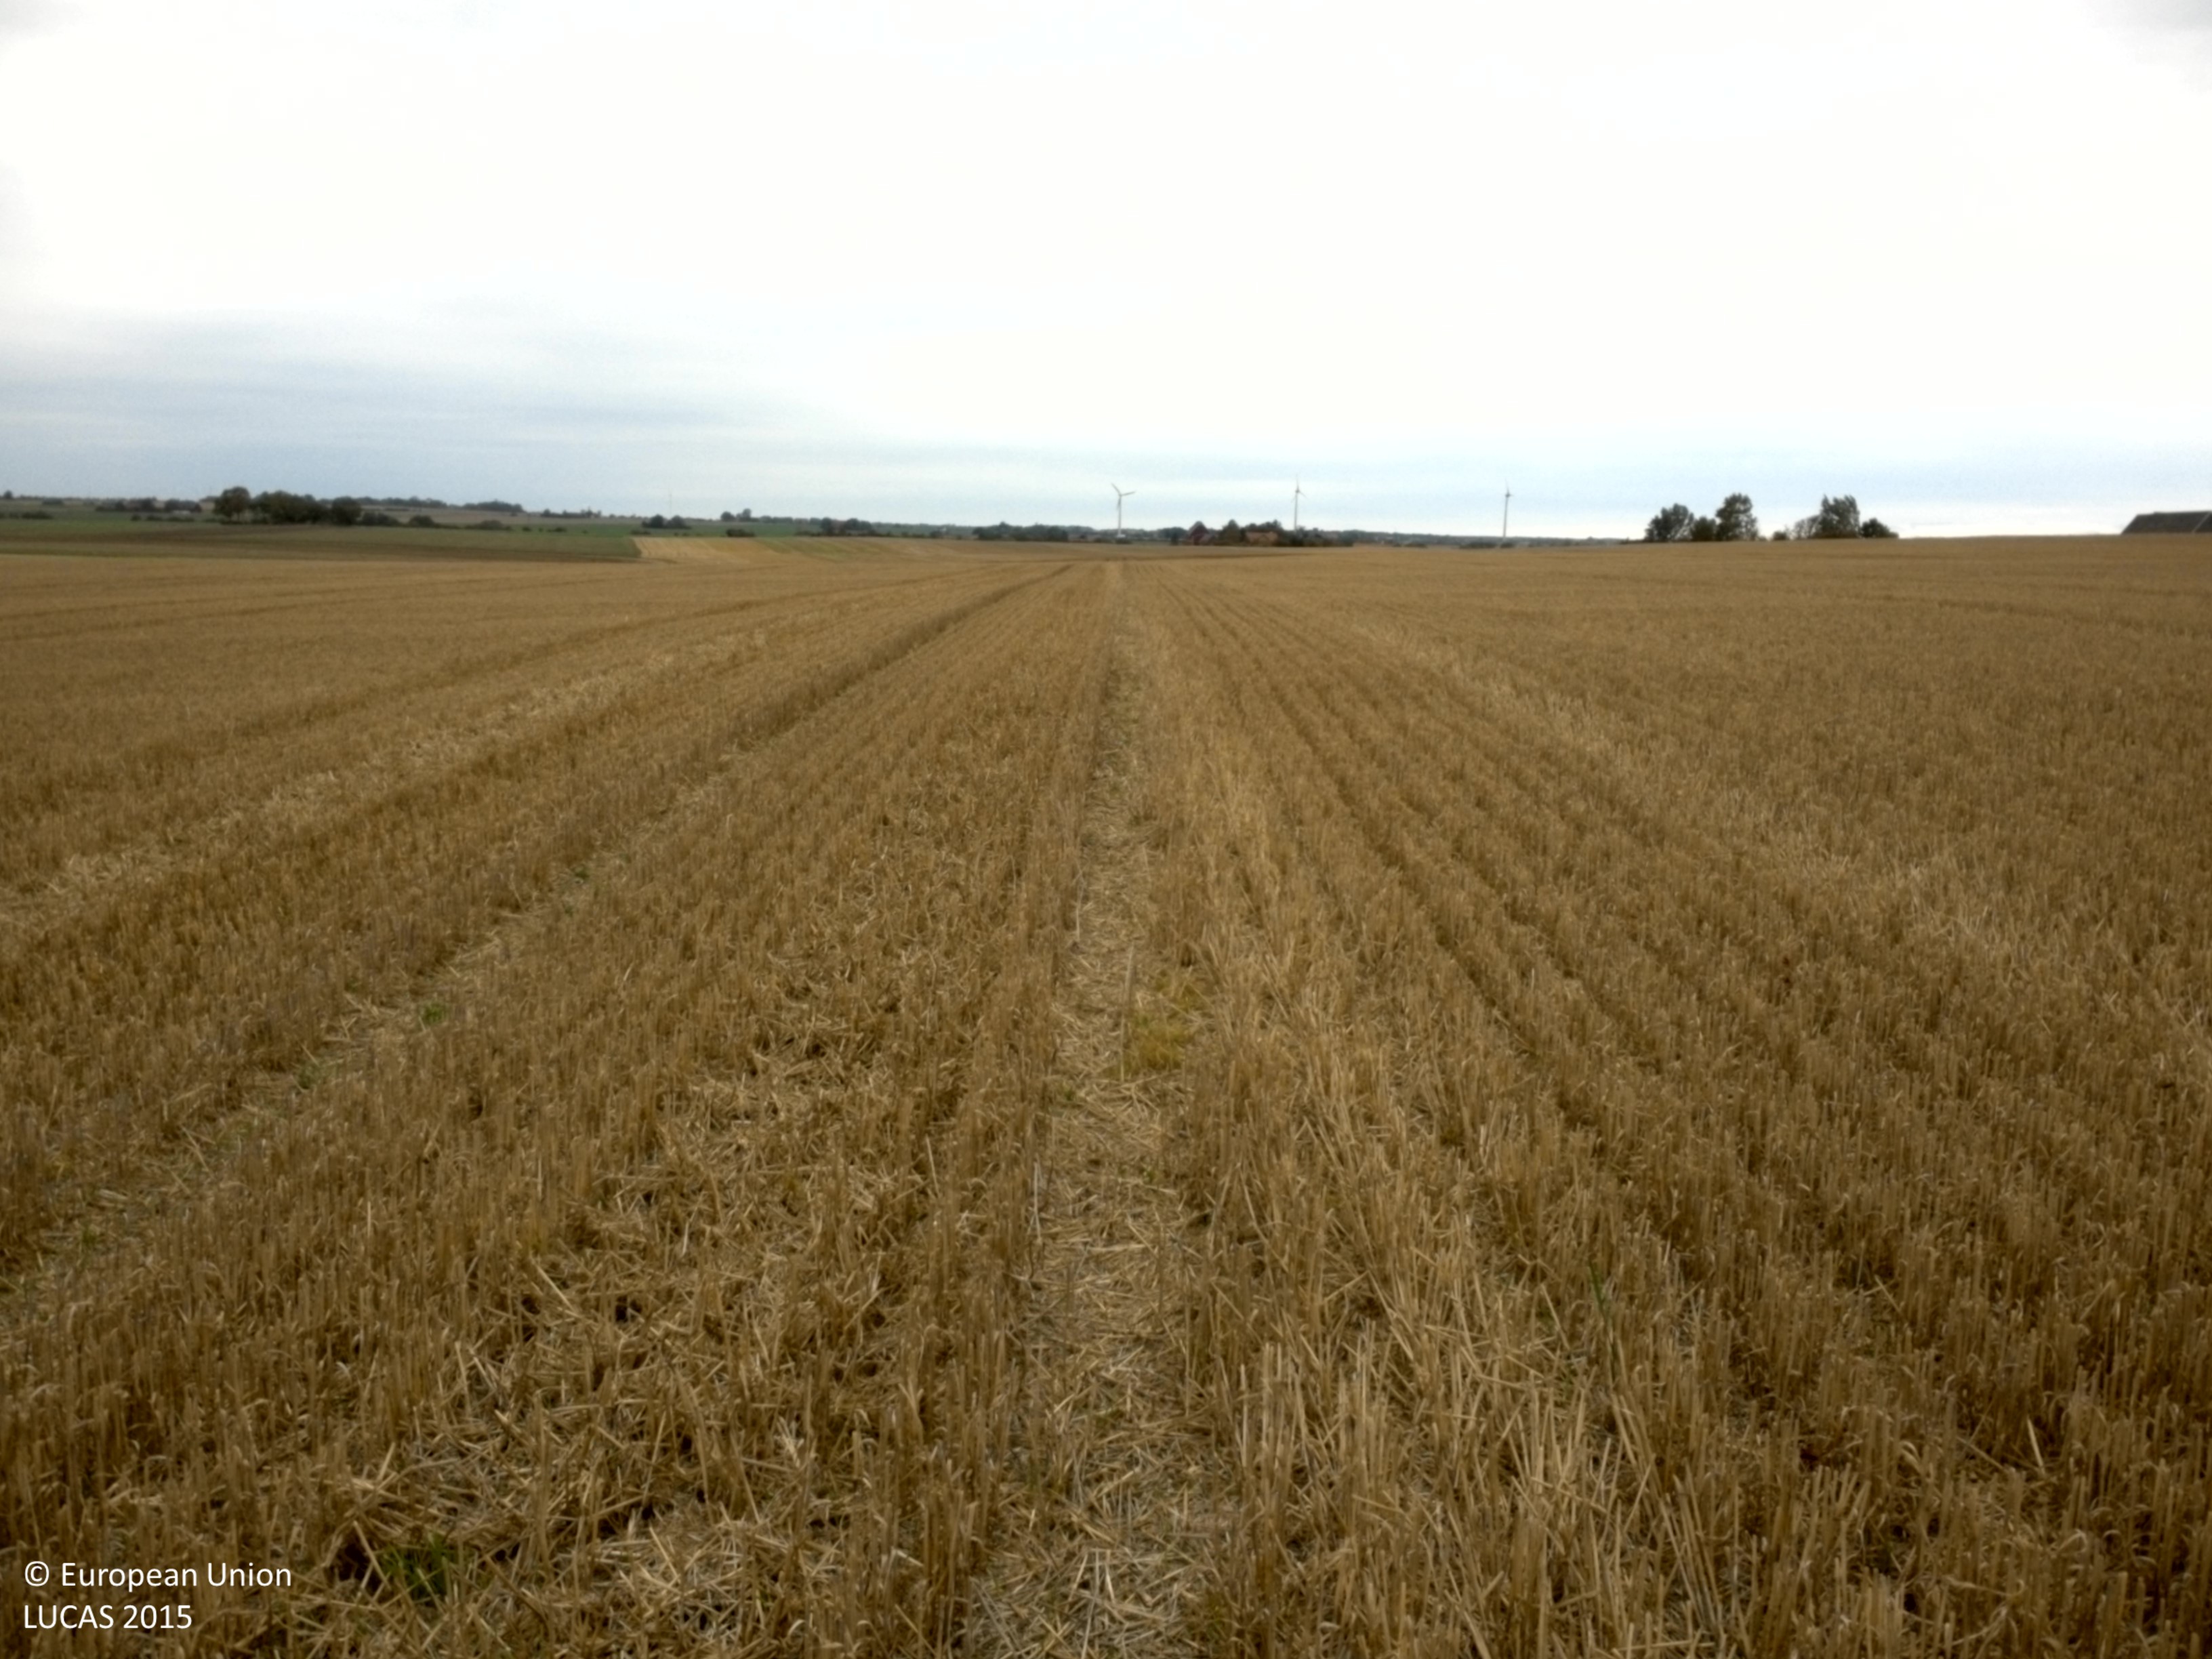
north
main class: Cropland
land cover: Common wheat
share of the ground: 25 - 50 %
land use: Agriculture (excluding fallow land and kitchen gardens)
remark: Harvested field
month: October
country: SE
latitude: 55.8794
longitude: 13.1468
